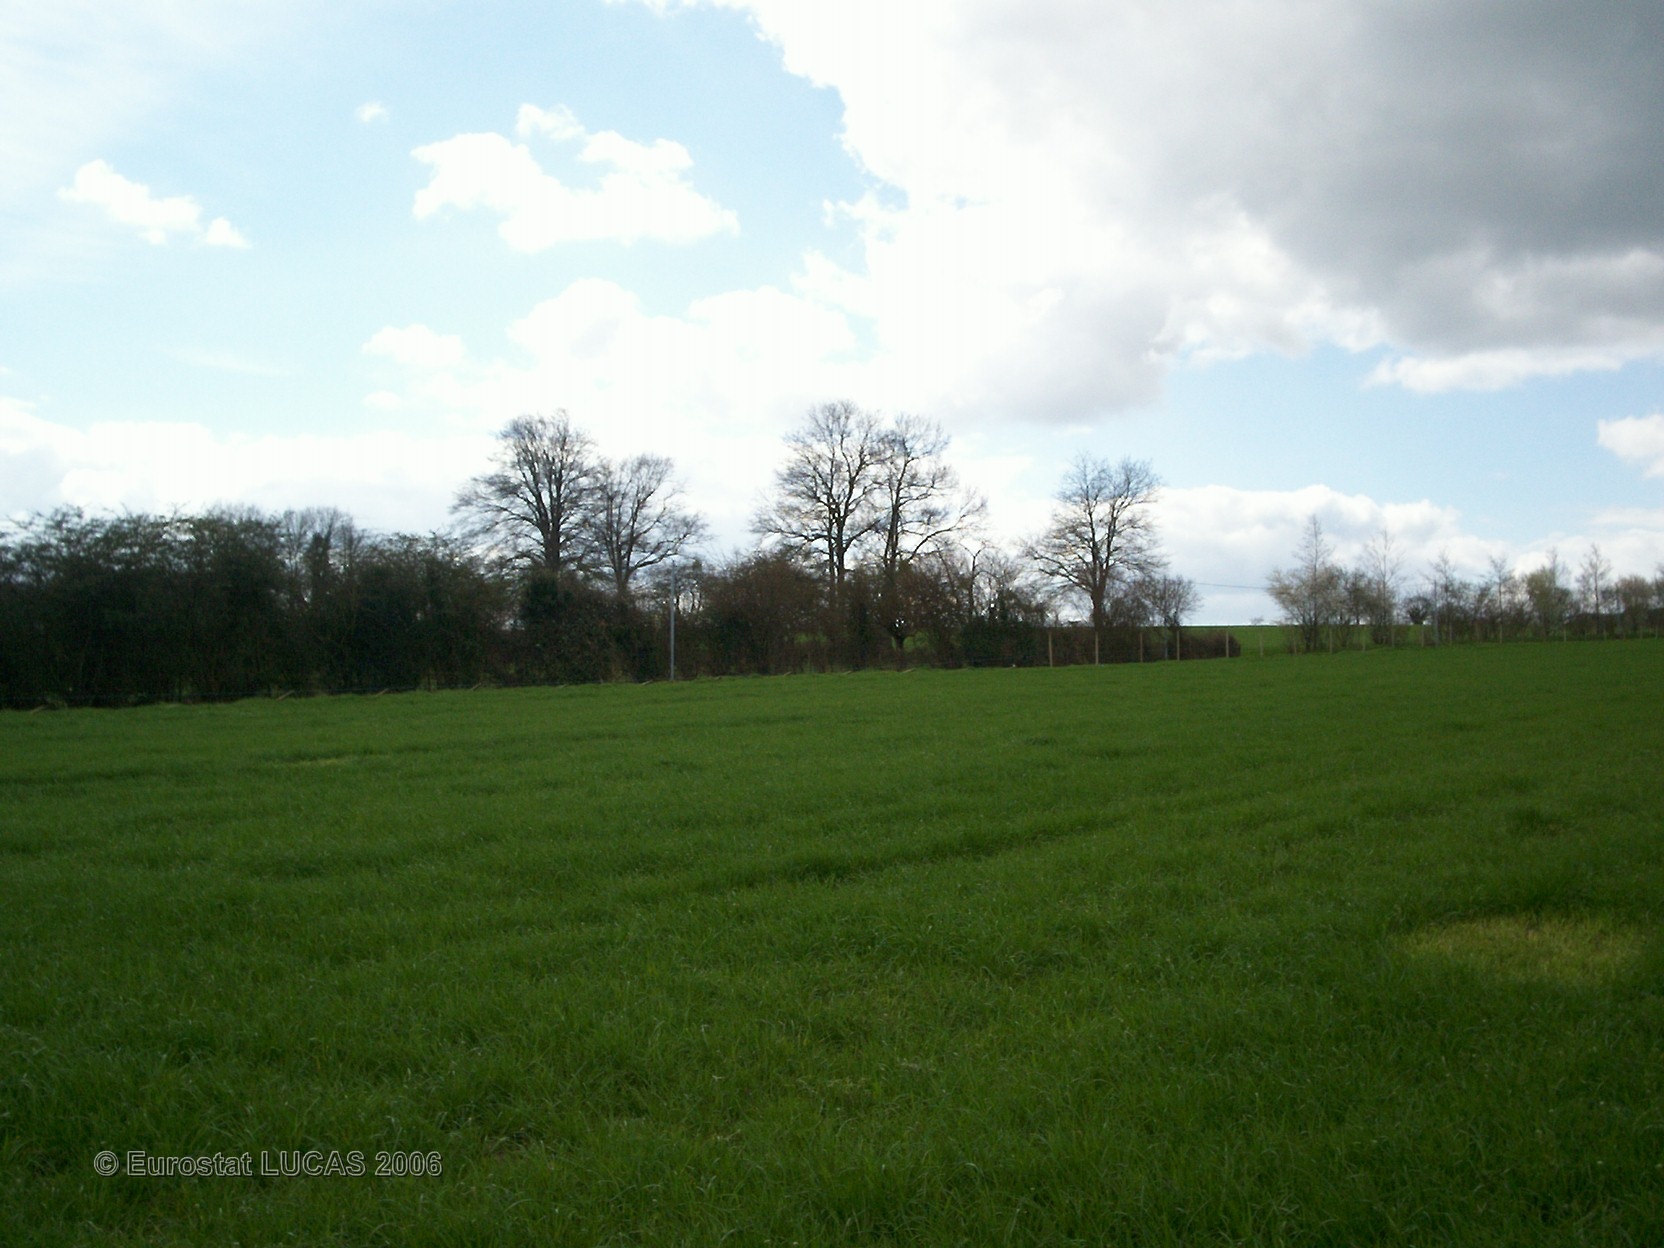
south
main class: Grassland
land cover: Grassland without tree/shrub cover
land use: Agriculture (excluding fallow land and kitchen gardens)
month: April
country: FR
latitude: 48.3054
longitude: -0.2647
